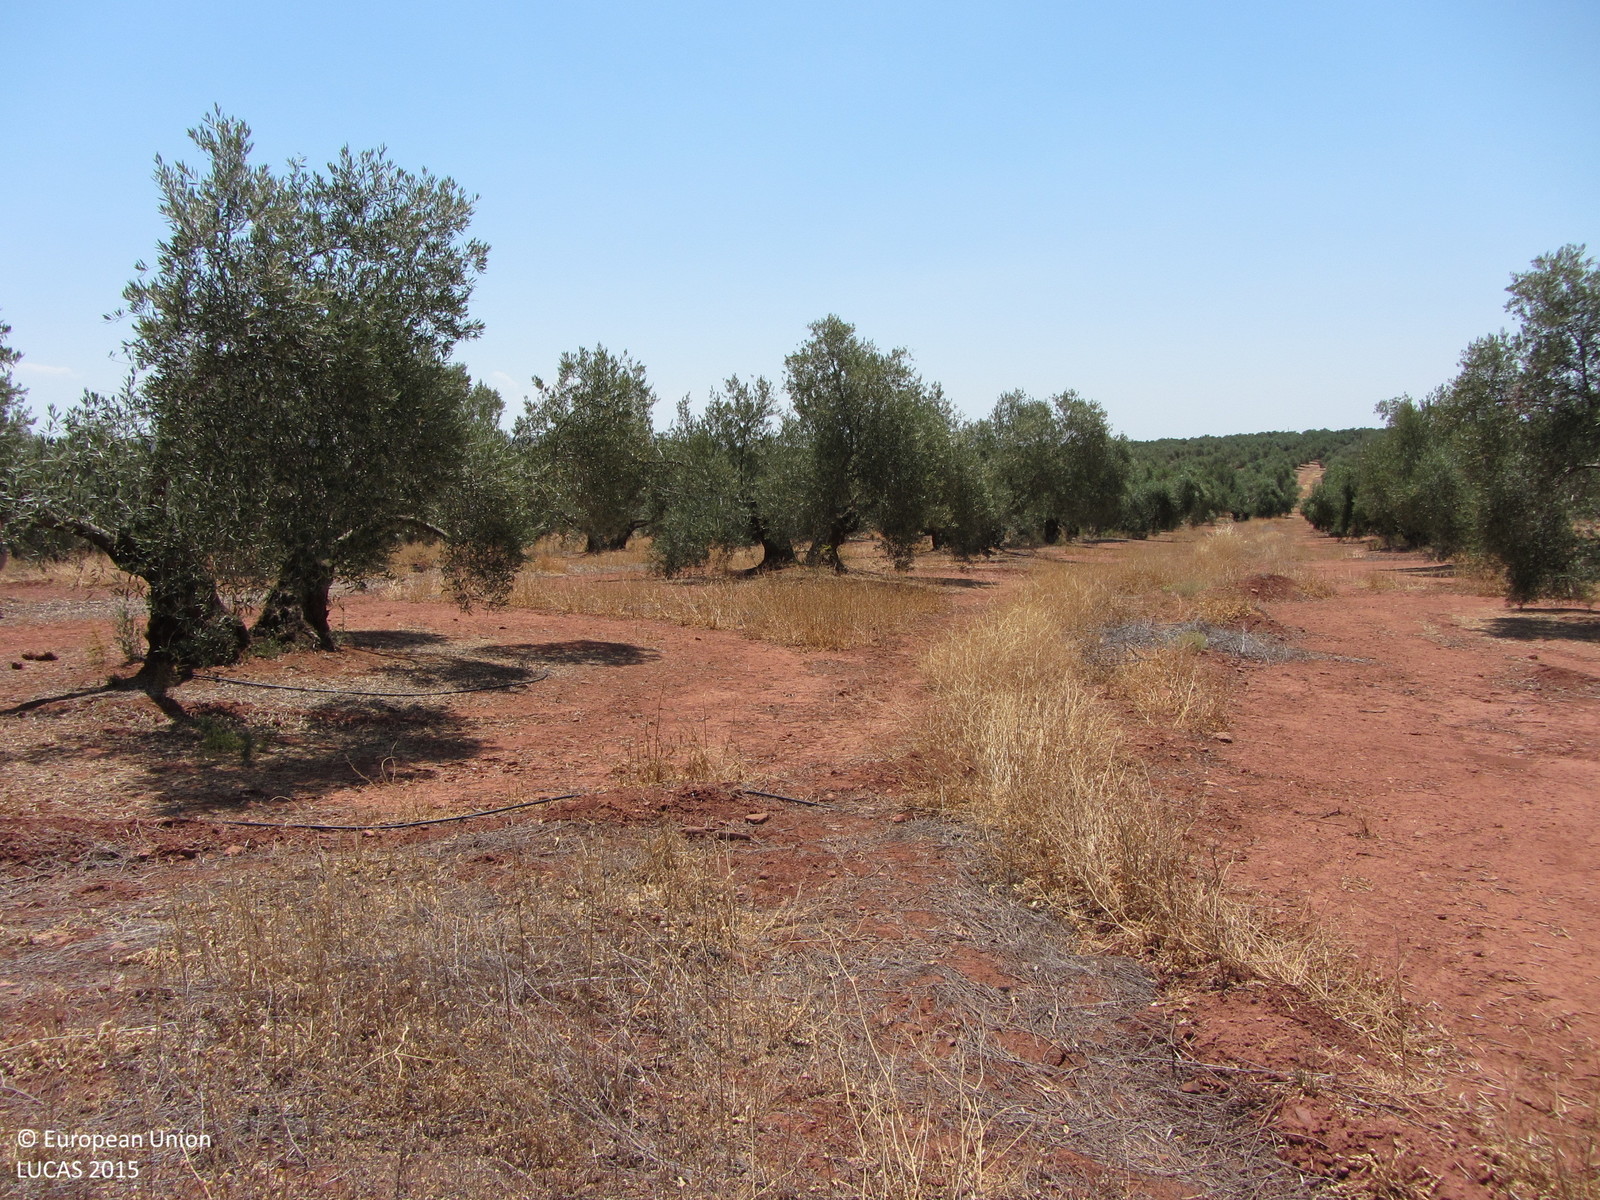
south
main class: Cropland
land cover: Olive groves
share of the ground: 25 - 50 %
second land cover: Other bare soil
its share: > 75 %
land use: Agriculture (excluding fallow land and kitchen gardens)
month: June
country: ES
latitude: 38.2011
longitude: -3.4440
